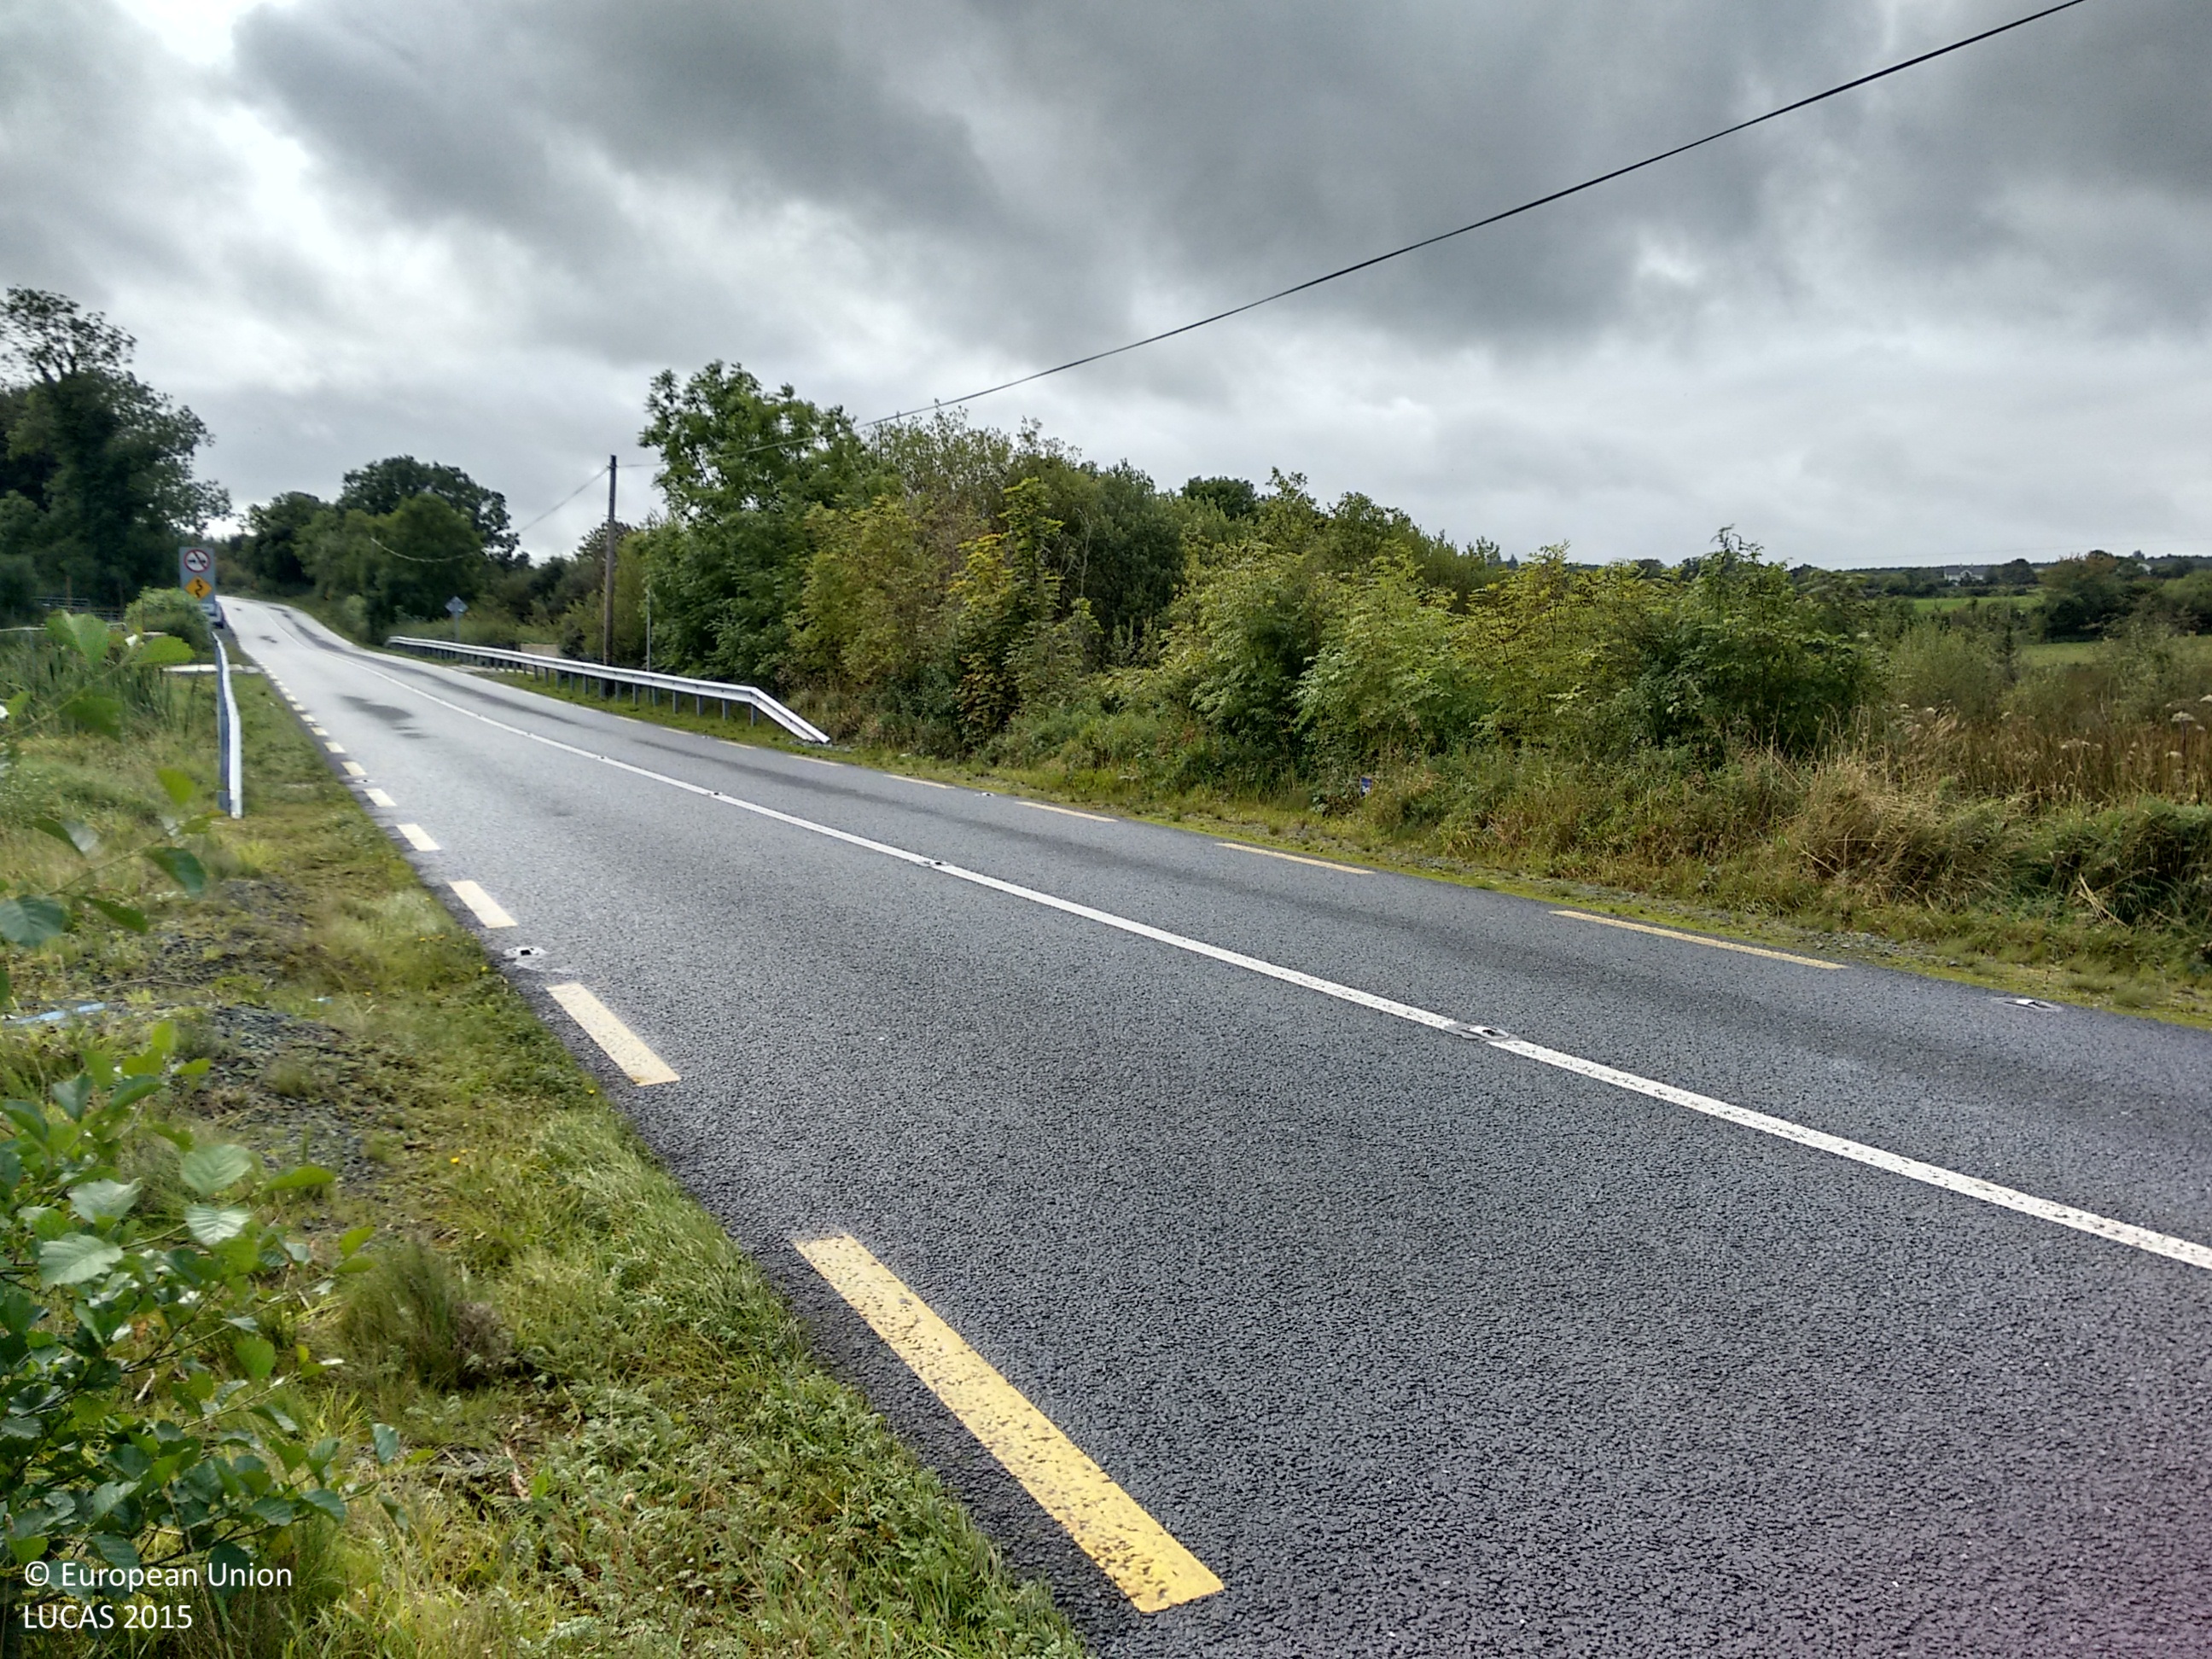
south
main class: Grassland
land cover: Grassland without tree/shrub cover
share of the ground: > 75 %
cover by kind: herbaceous plants 100 %
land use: Agriculture (excluding fallow land and kitchen gardens)
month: September
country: IE
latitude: 54.9213
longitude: -7.5852
